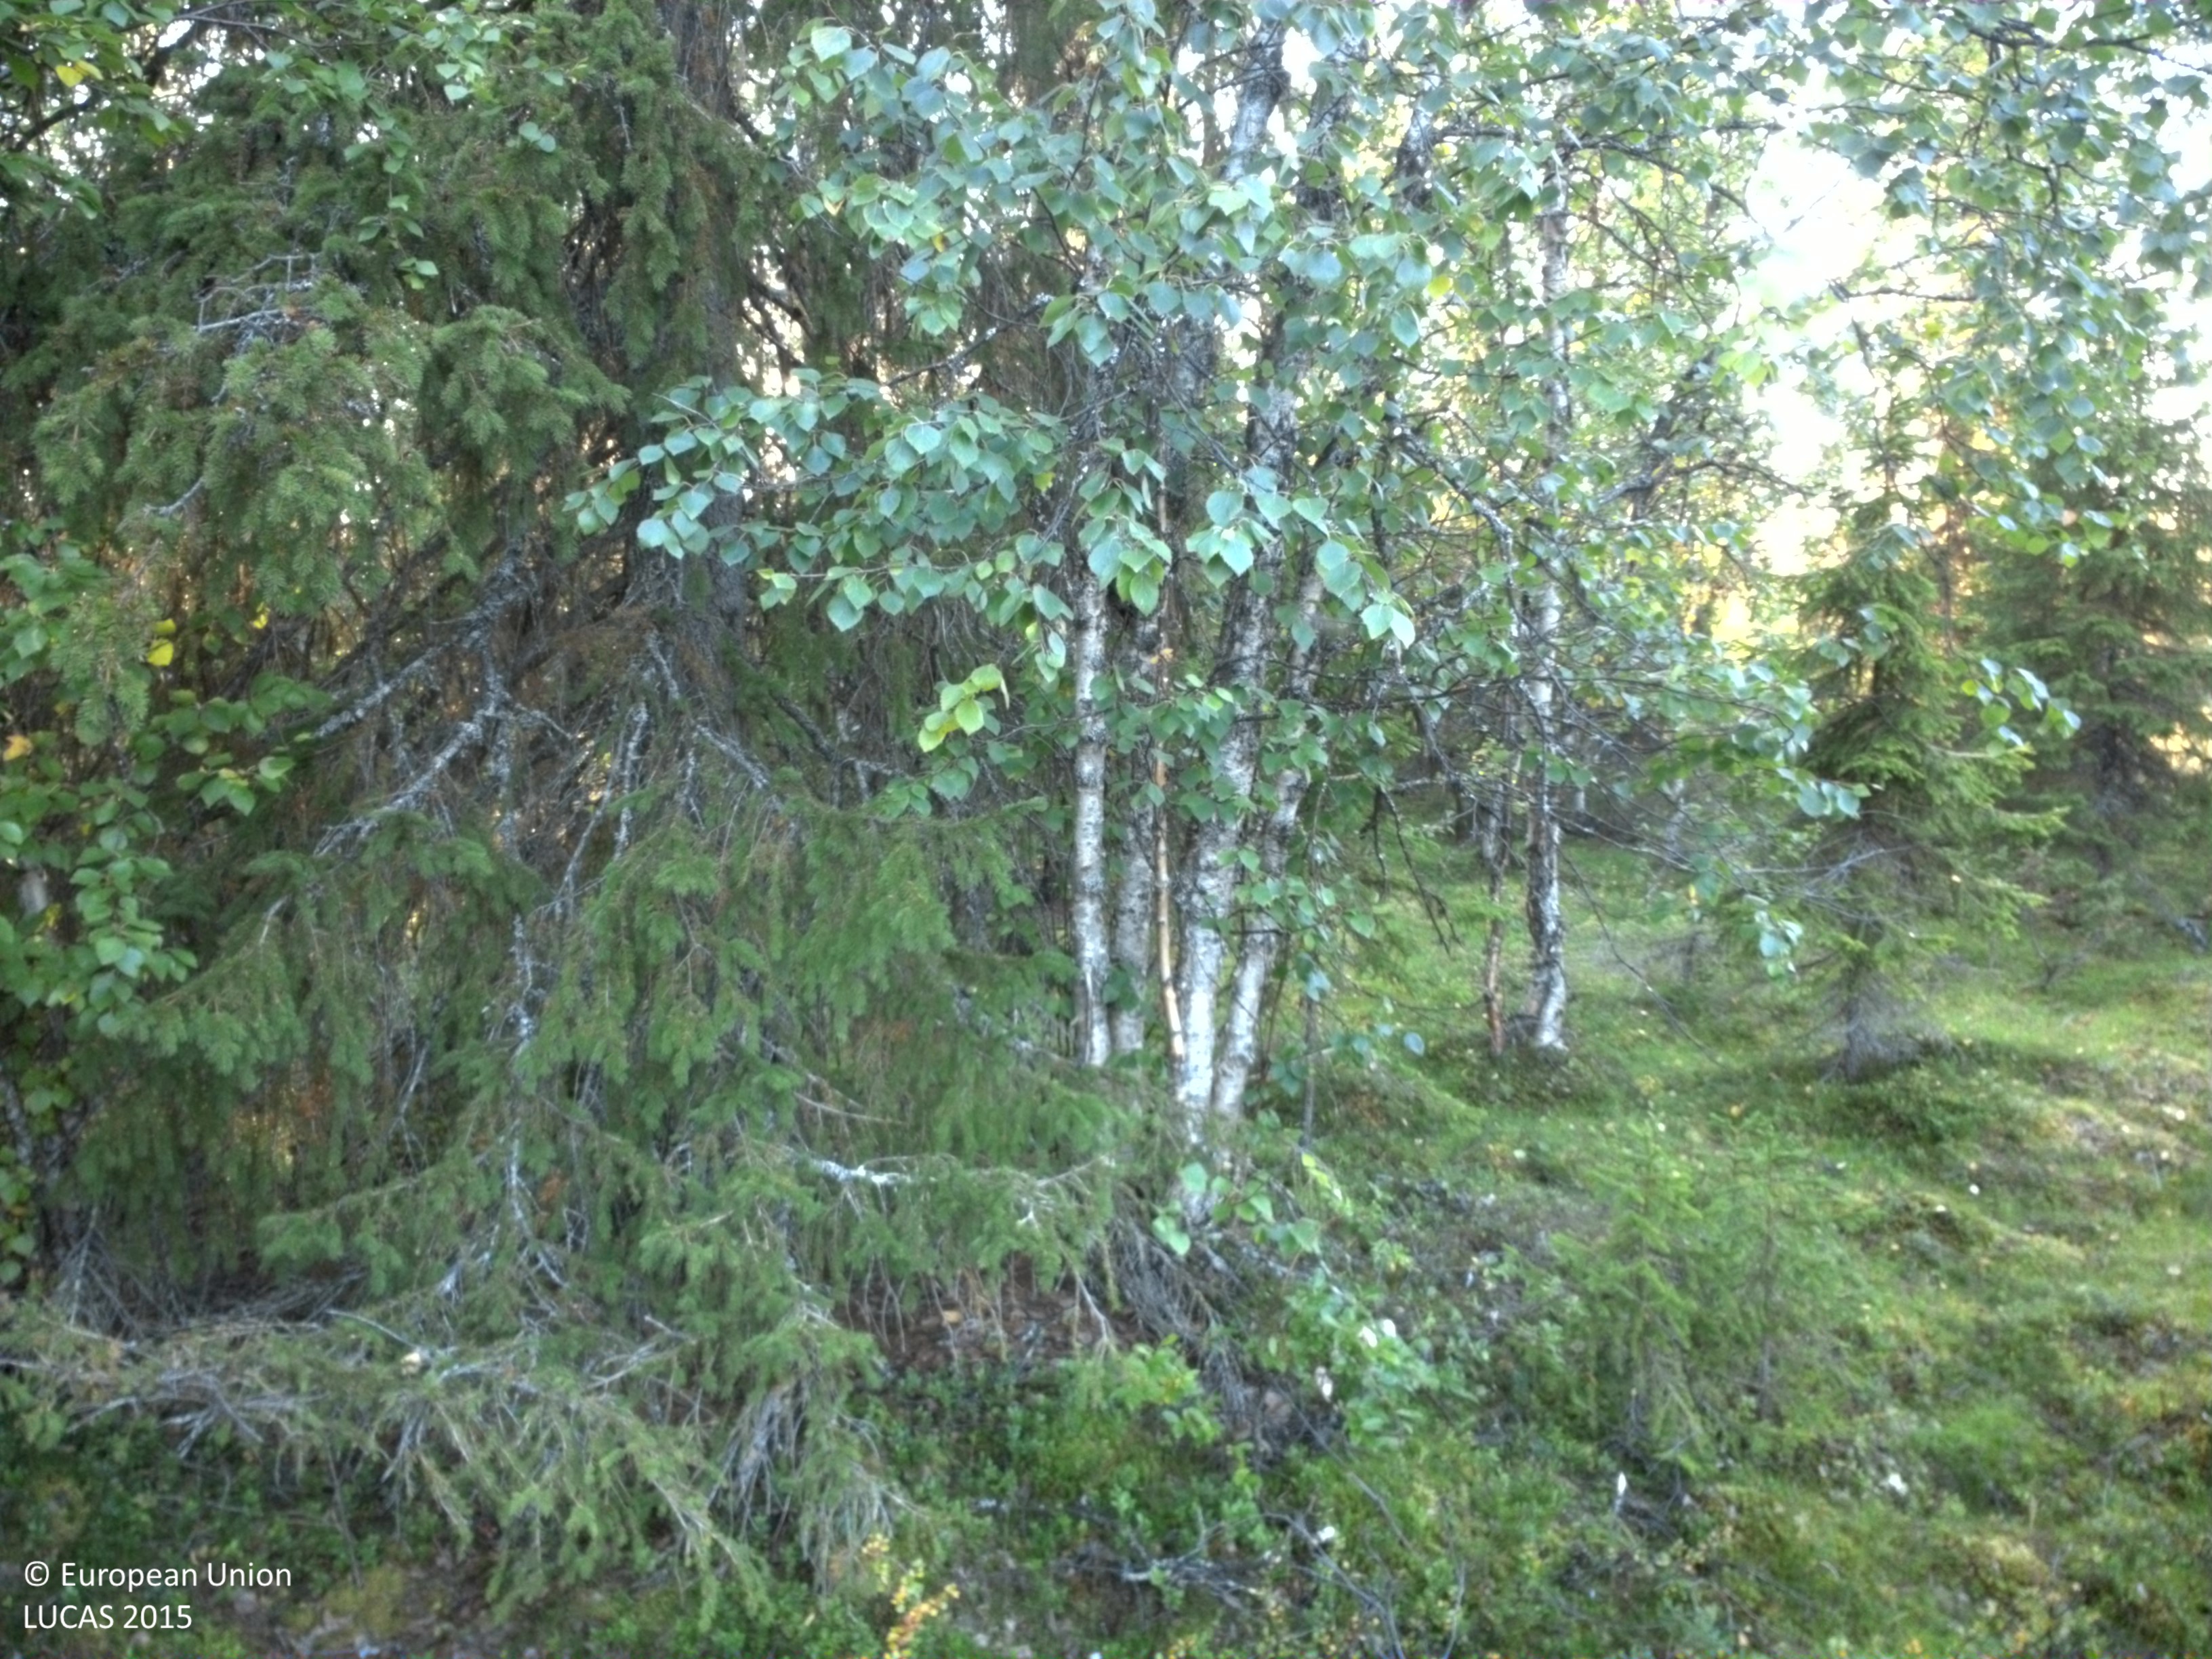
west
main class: Shrubland
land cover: Shrubland with sparse tree cover
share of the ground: 50 - 75 %
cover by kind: shrubs 50 %, lichens and mosses 35 %, herbaceous plants 10 %, broadleaved forest trees 5 %
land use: Semi-natural and natural areas not in use
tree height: > 5 m
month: September
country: SE
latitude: 65.2623
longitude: 16.0252
